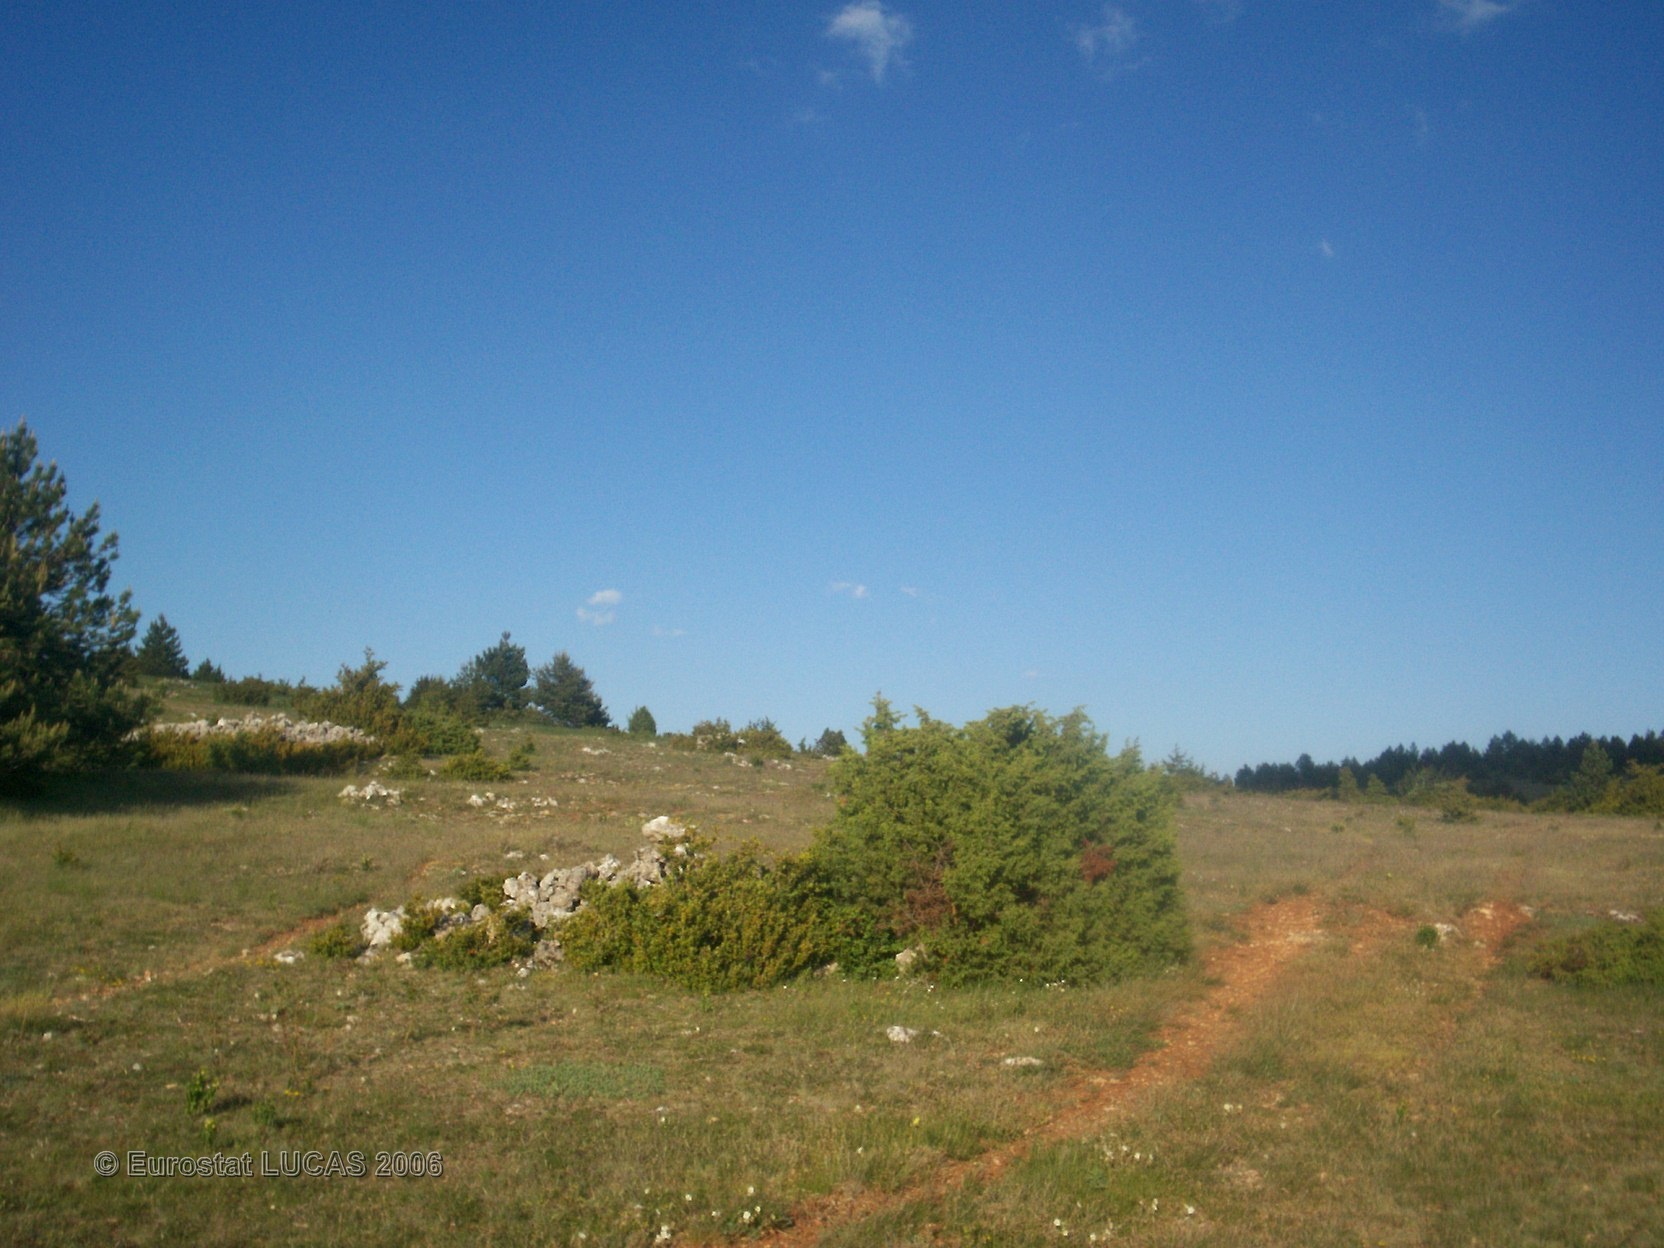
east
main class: Grassland
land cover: Grassland without tree/shrub cover
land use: Agriculture (excluding fallow land and kitchen gardens)
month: June
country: FR
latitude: 44.3243
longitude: 3.4477
